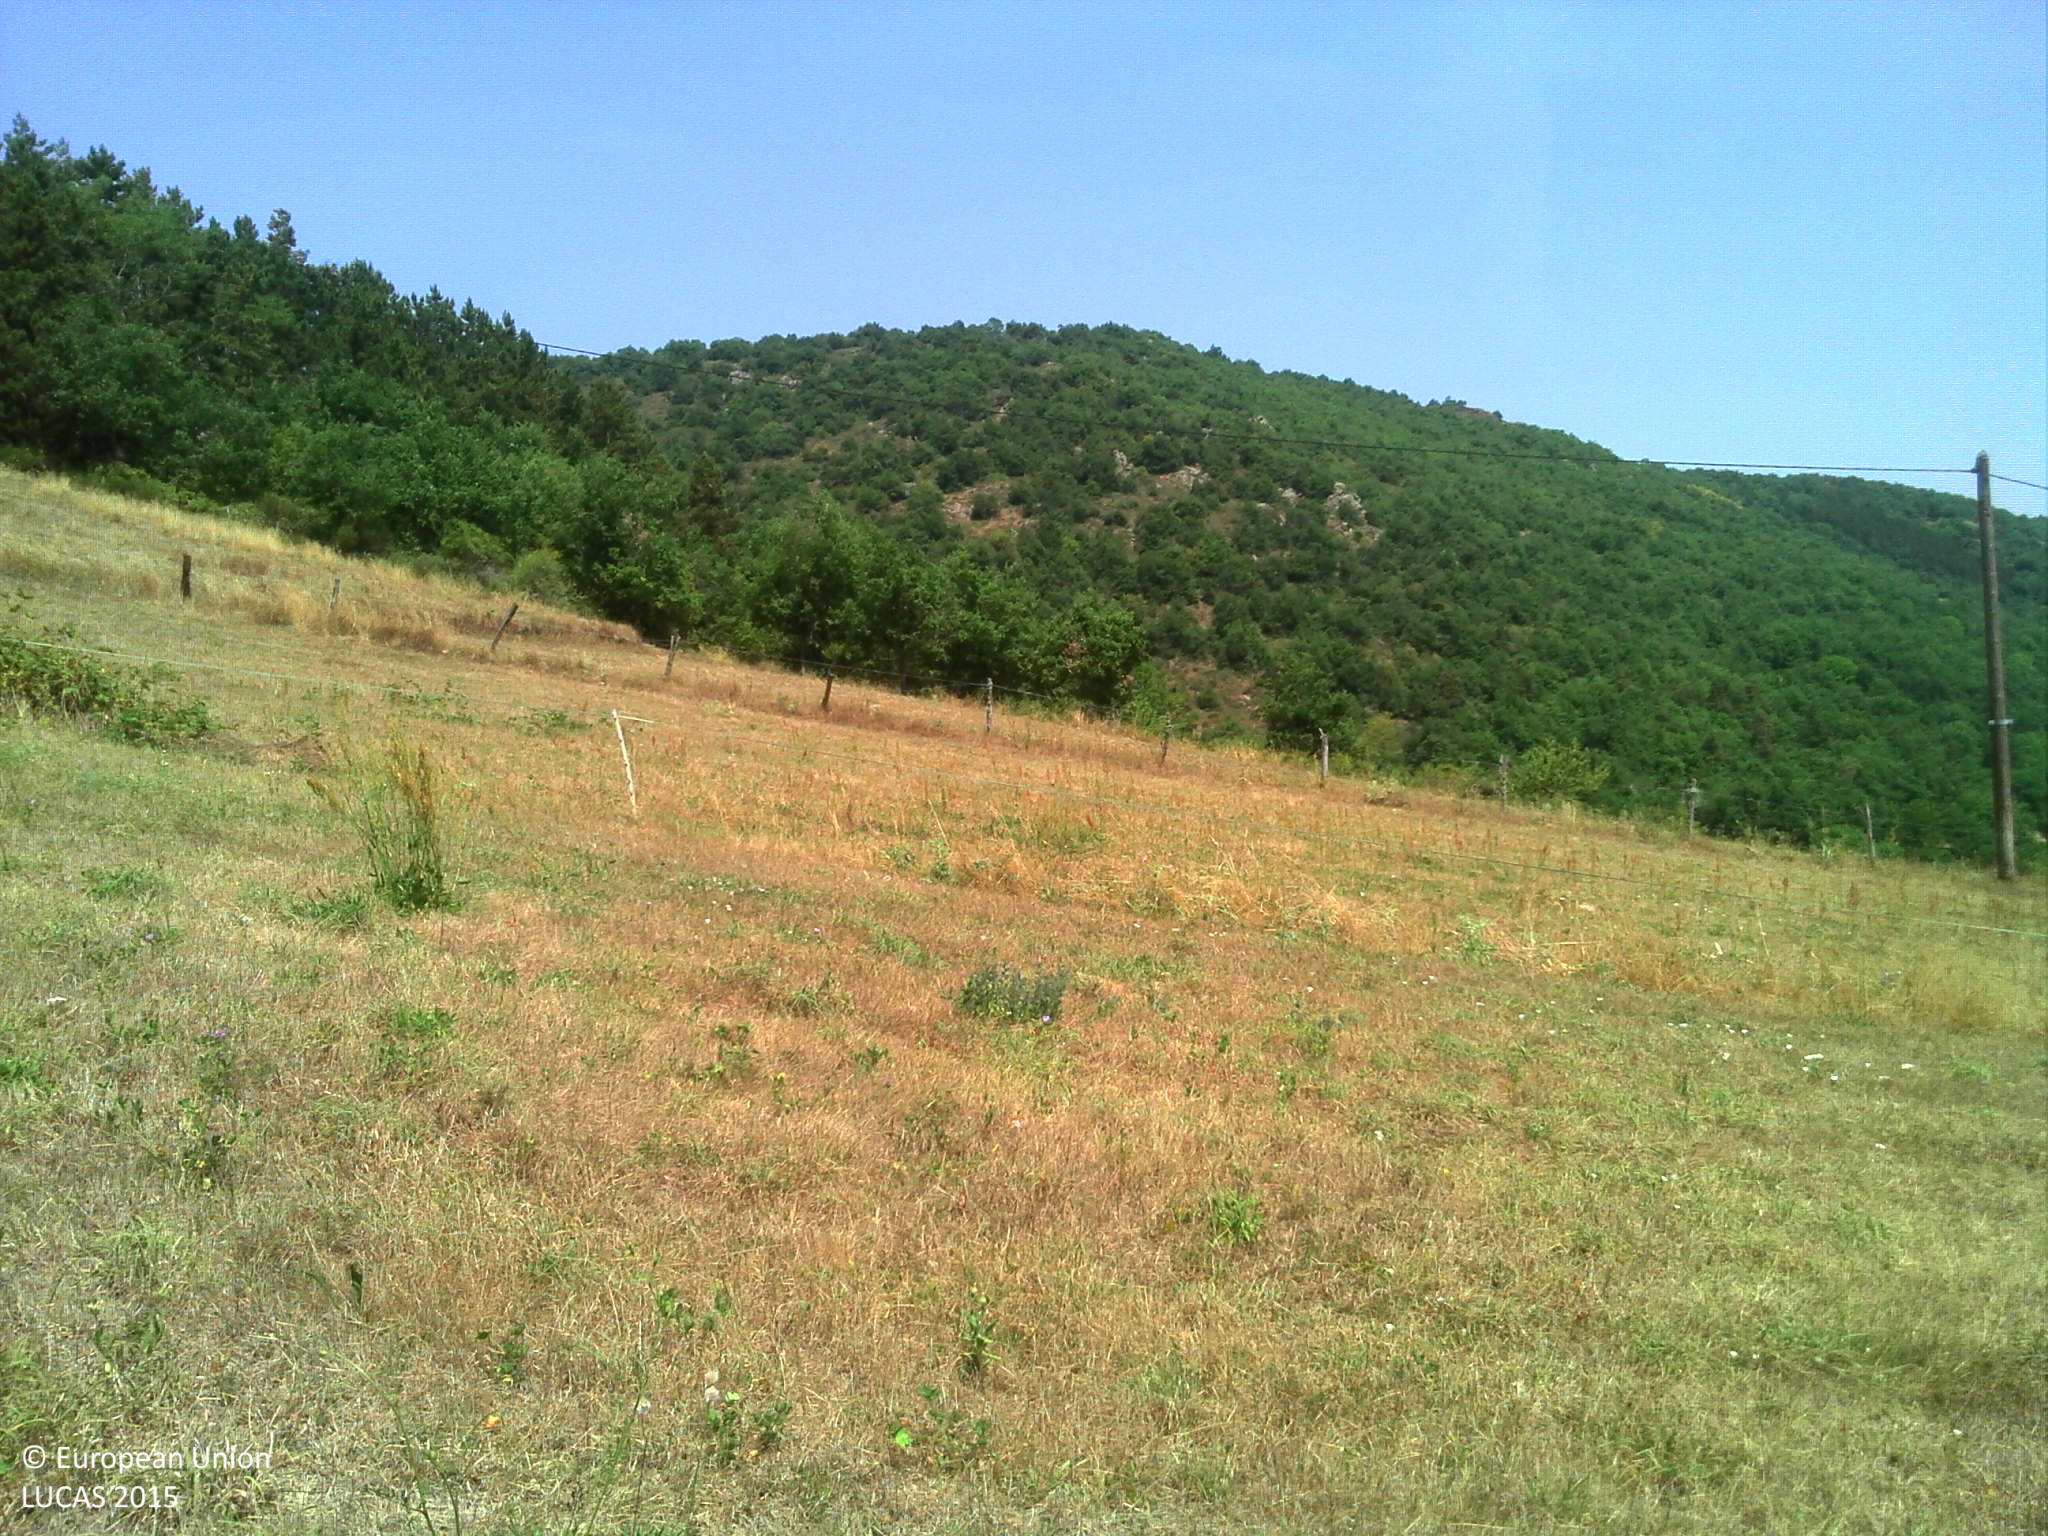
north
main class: Grassland
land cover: Grassland without tree/shrub cover
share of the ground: > 75 %
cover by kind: herbaceous plants 100 %
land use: Agriculture (excluding fallow land and kitchen gardens)
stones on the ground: < 10 %
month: July
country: FR
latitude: 45.3393
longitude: 3.1997
